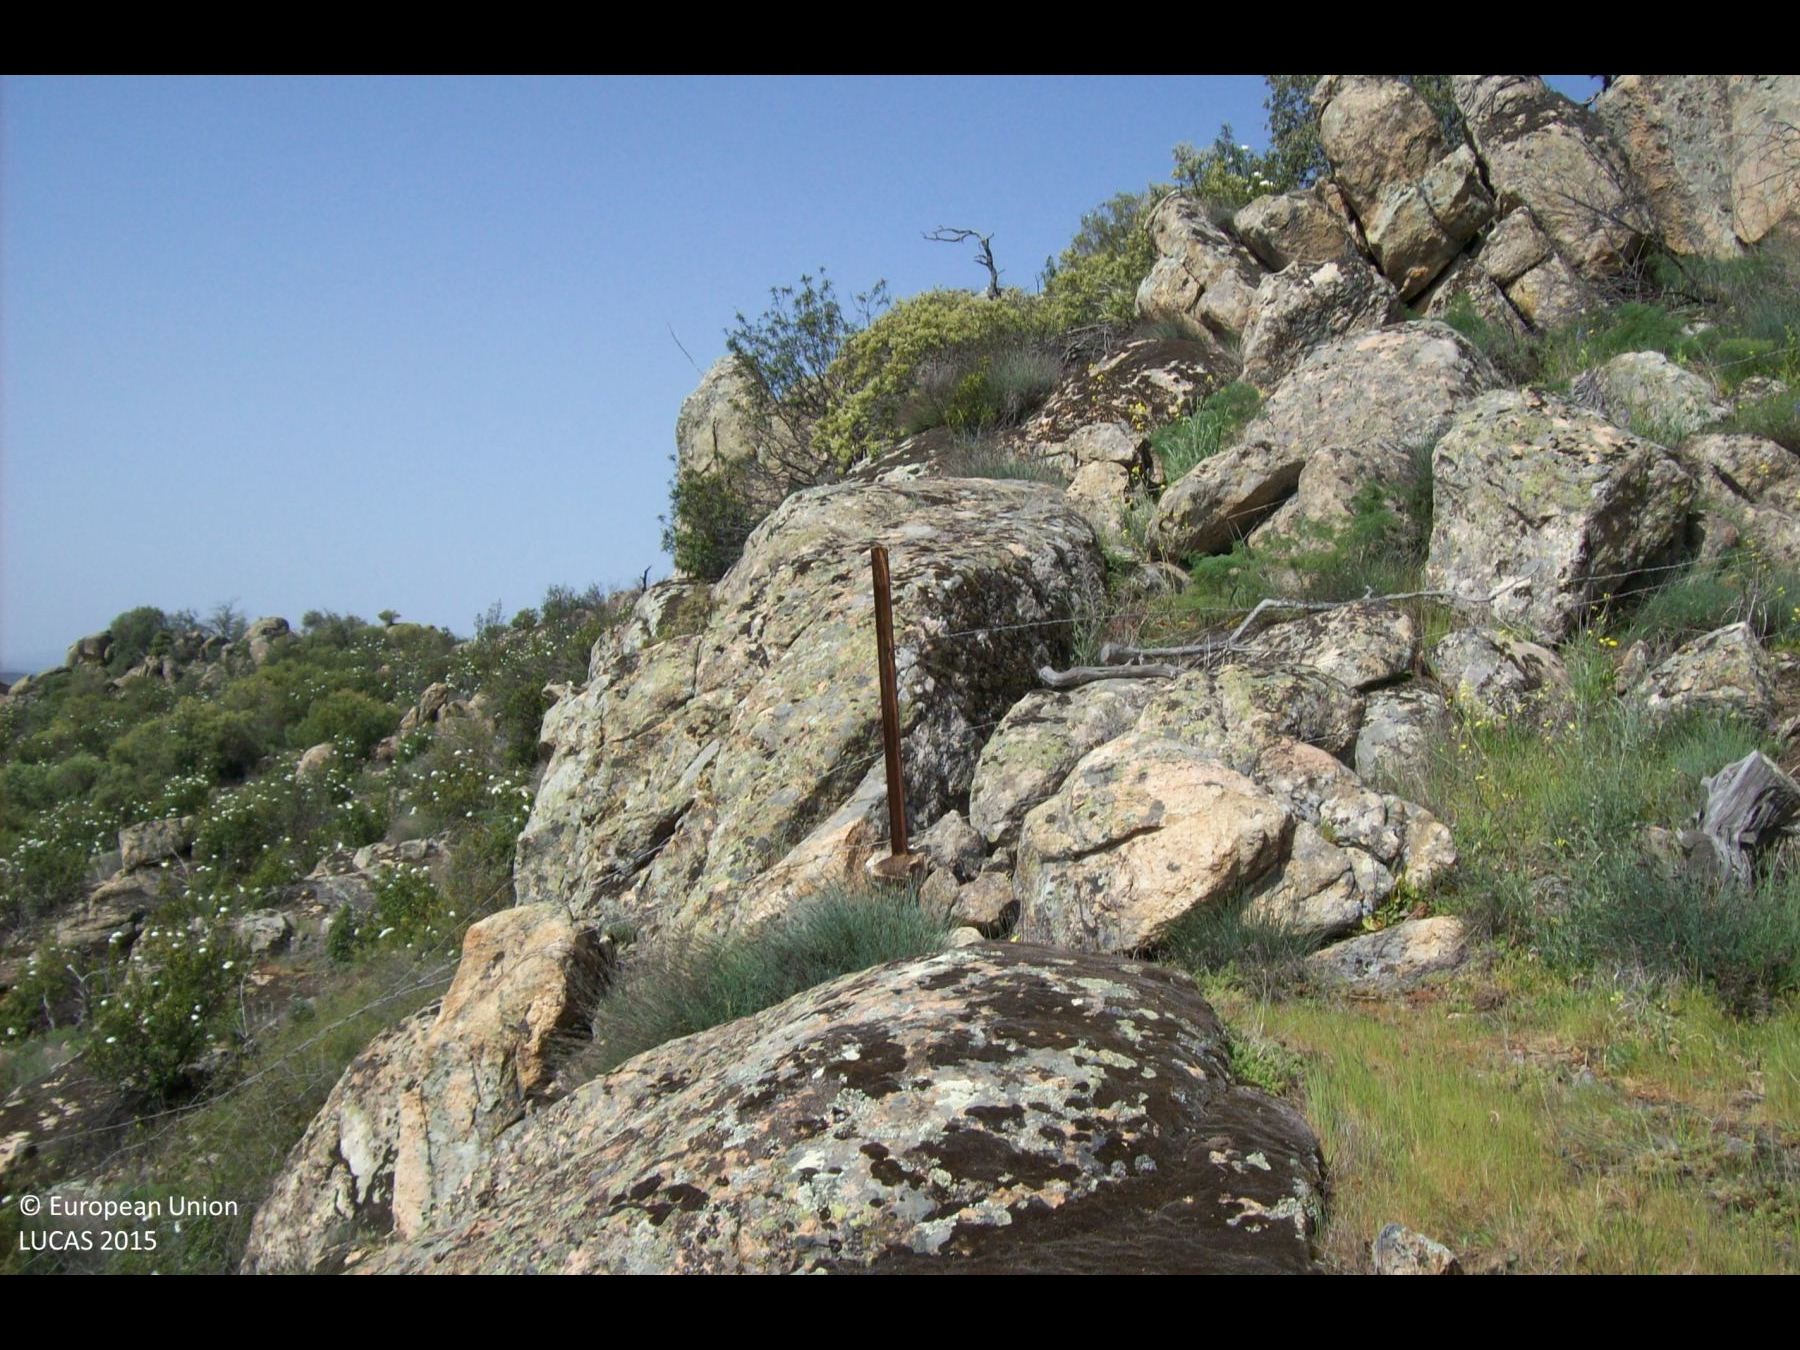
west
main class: Shrubland
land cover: Shrubland with sparse tree cover
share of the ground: > 75 %
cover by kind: consolidated bare surface 55 %, shrubs 25 %, herbaceous plants 15 %, coniferous forest trees 5 %
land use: Semi-natural and natural areas not in use
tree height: < 5 m
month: April
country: ES
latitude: 40.5882
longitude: -3.9257
